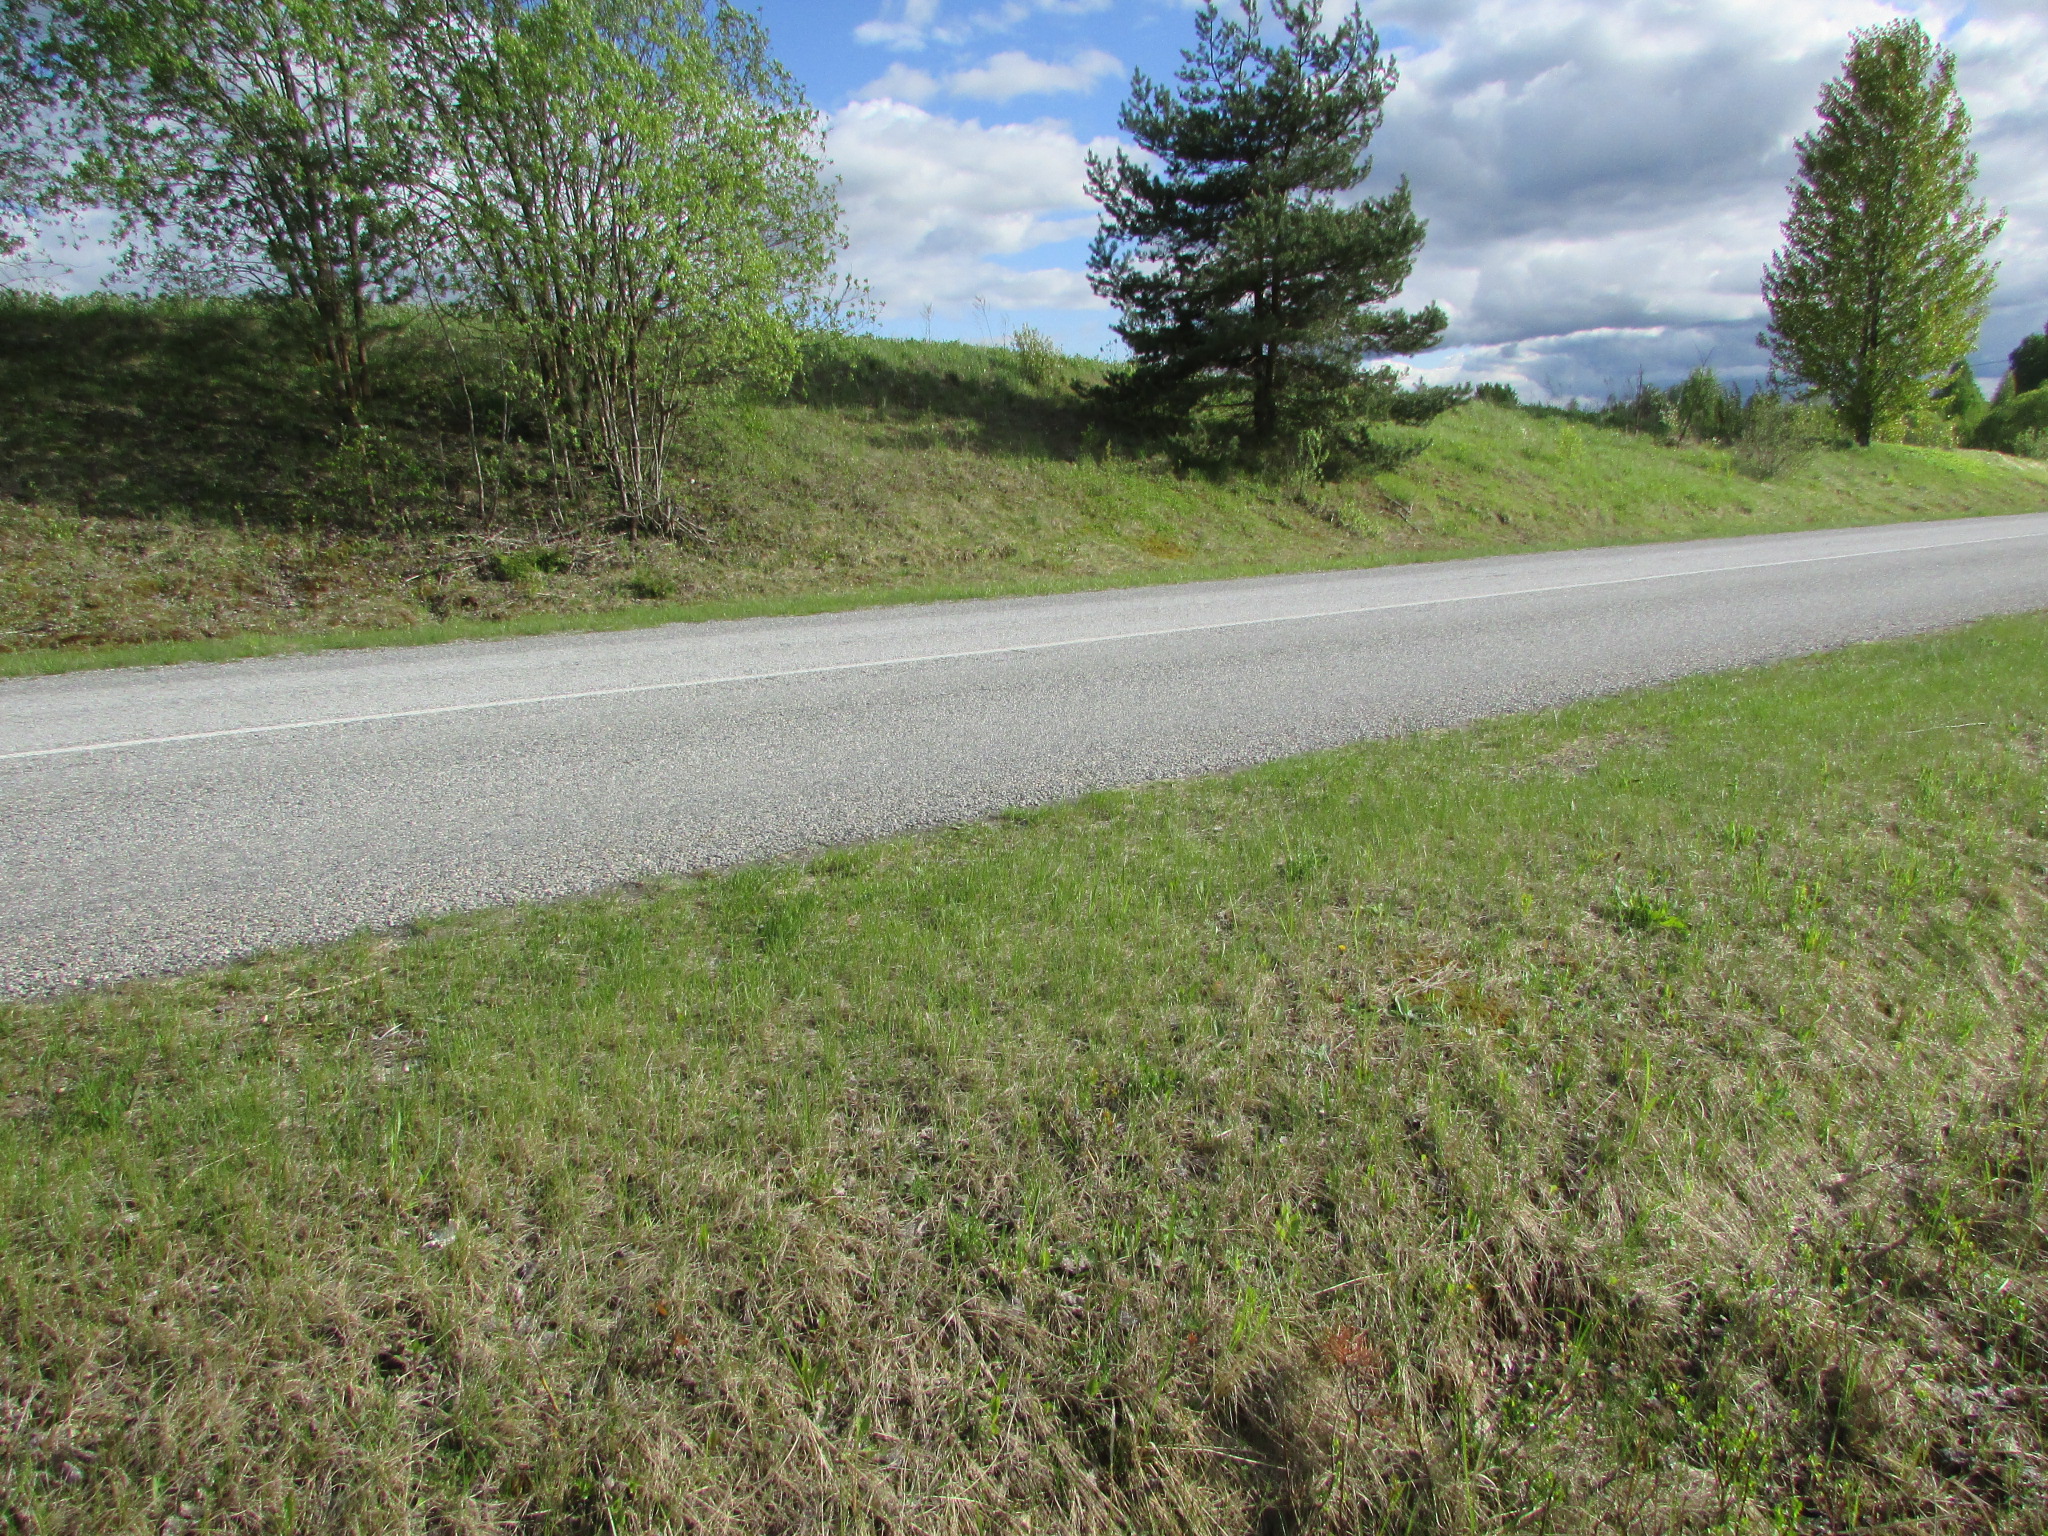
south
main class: Grassland
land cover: Grassland without tree/shrub cover
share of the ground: > 75 %
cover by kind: herbaceous plants 100 %
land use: Agriculture (excluding fallow land and kitchen gardens)
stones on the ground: < 10 %
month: May
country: LV
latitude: 56.1356
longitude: 27.0791
